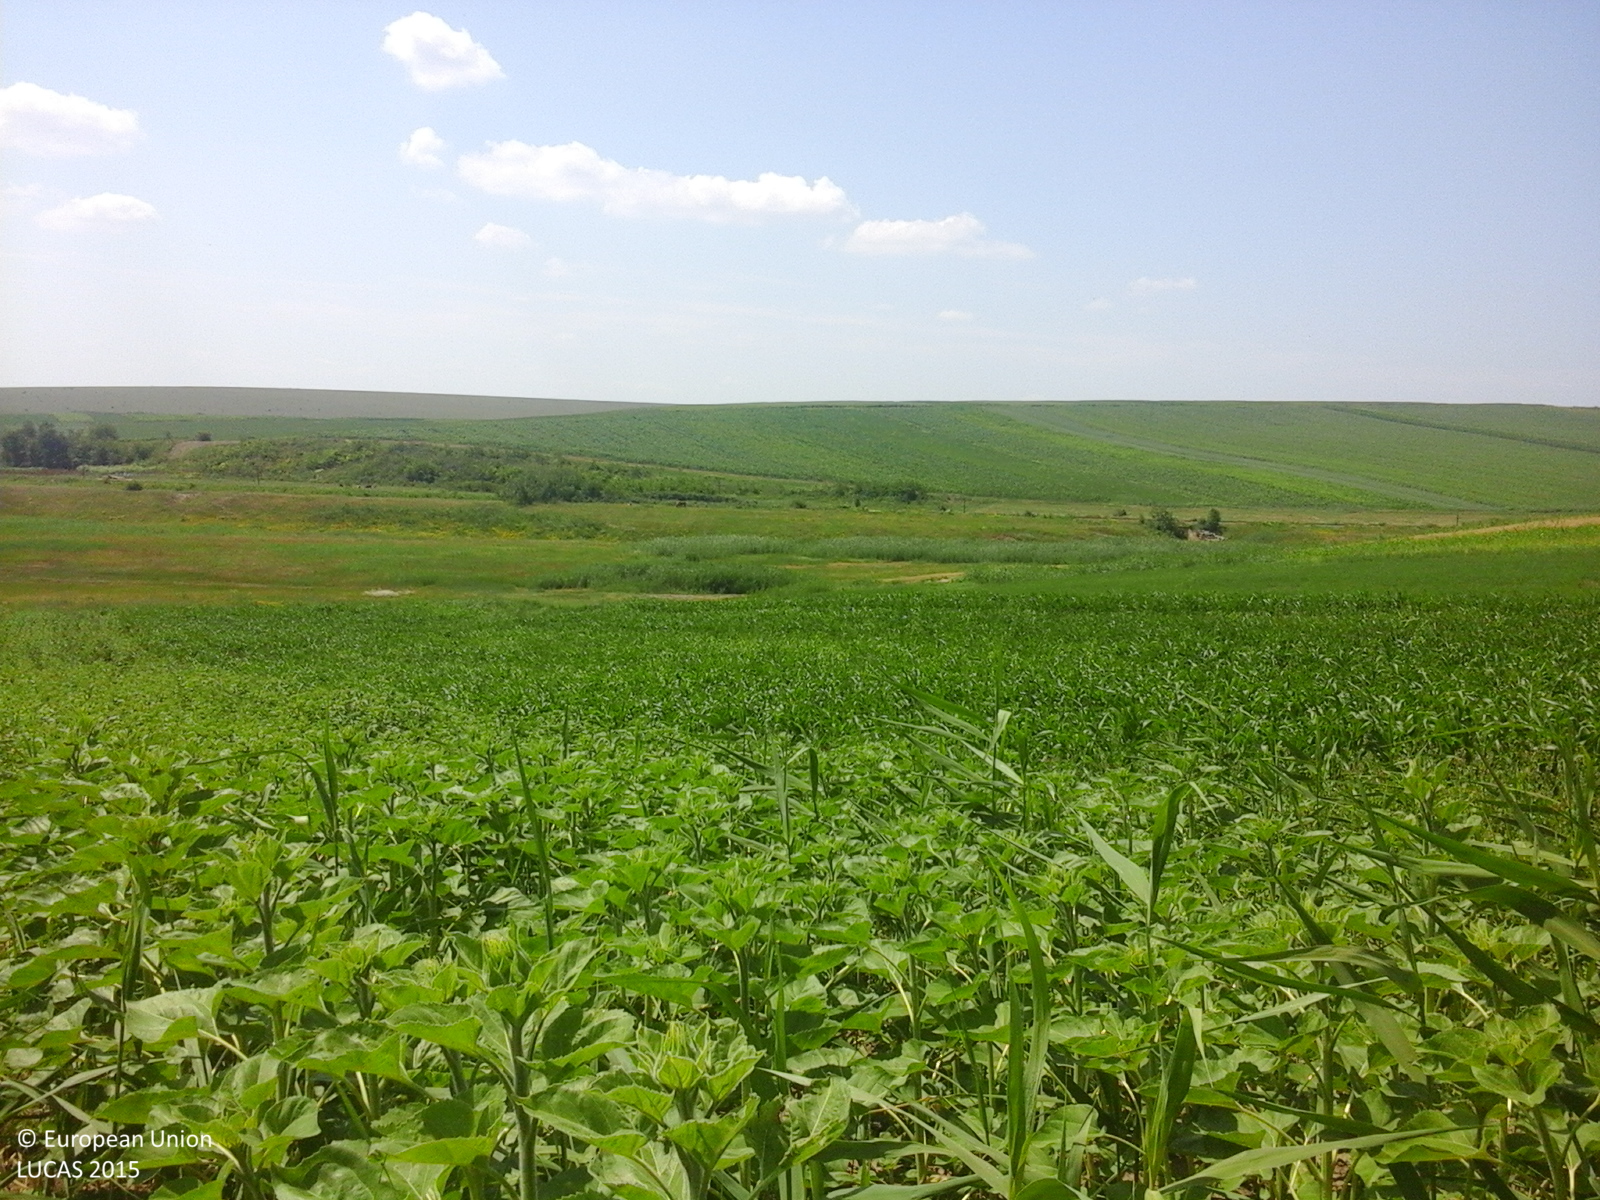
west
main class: Cropland
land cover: Sunflower
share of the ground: > 75 %
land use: Agriculture (excluding fallow land and kitchen gardens)
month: June
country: RO
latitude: 47.2516
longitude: 27.3824
